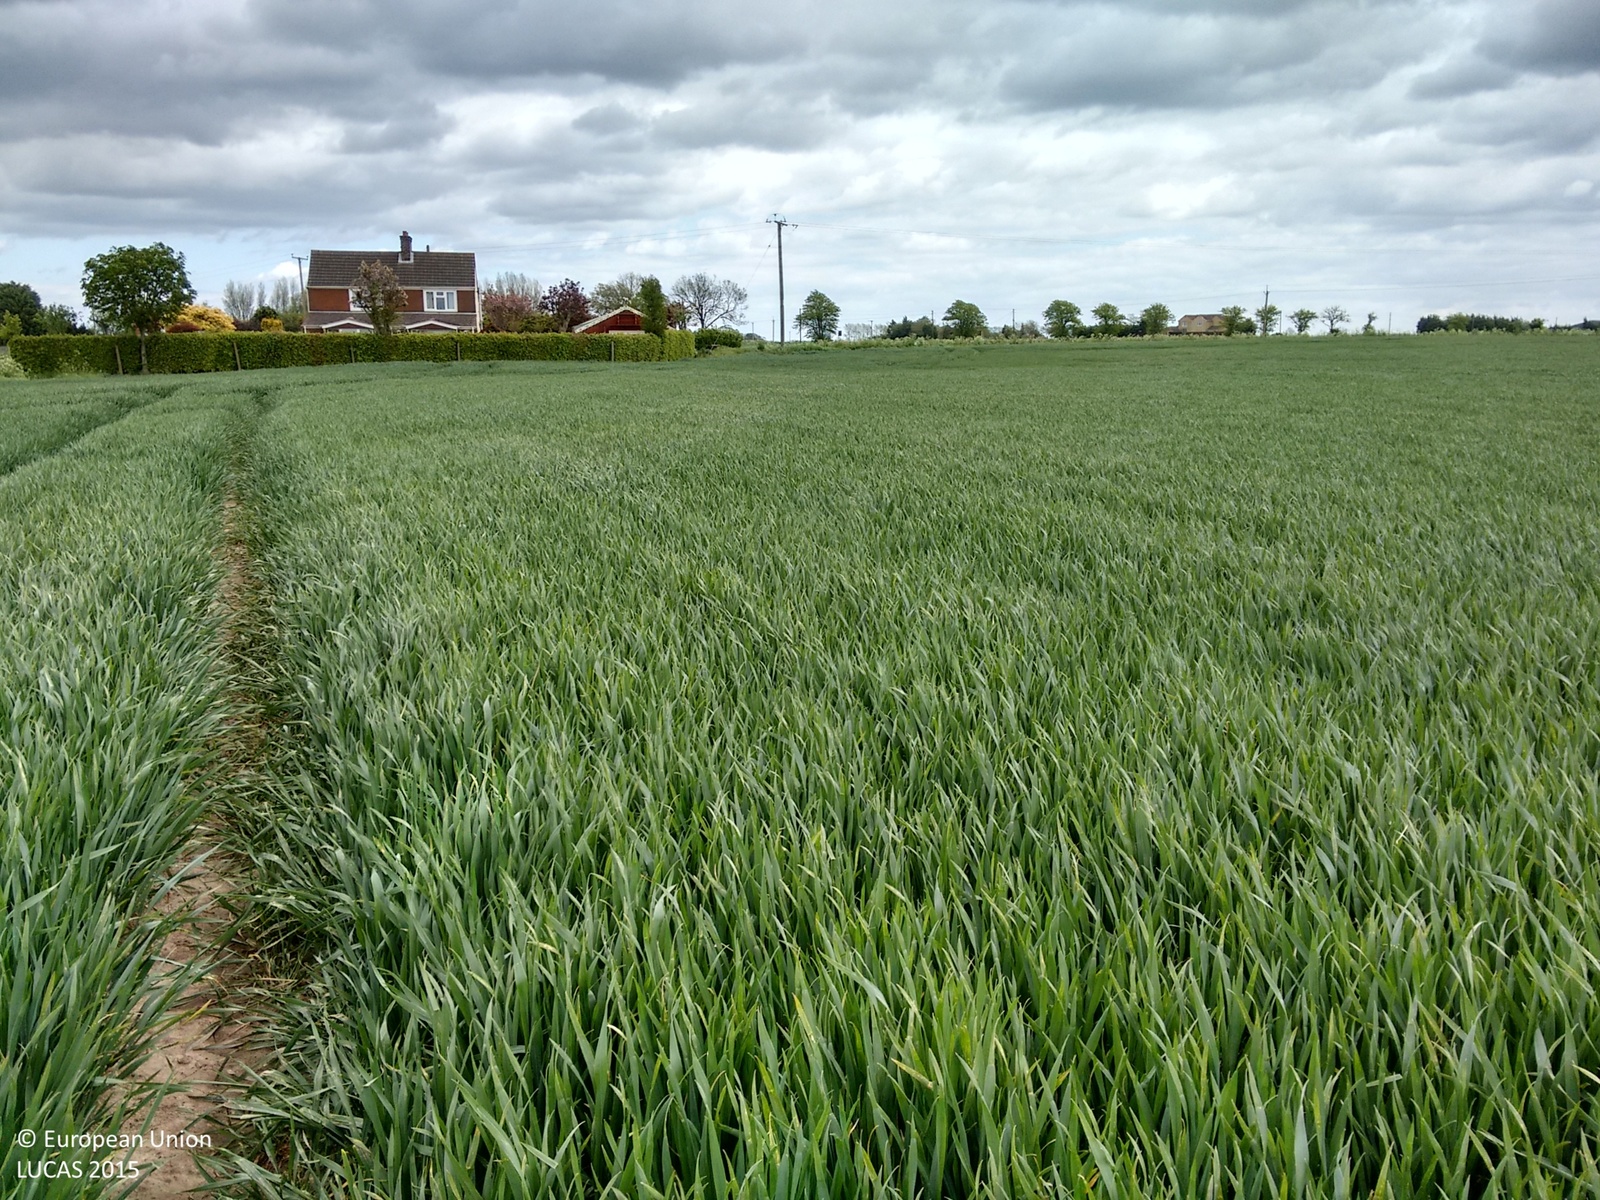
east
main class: Cropland
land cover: Barley
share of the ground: > 75 %
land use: Agriculture (excluding fallow land and kitchen gardens)
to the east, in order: Barley; Grass margins; Electric lines; Grass margins; Ditches and canals; Grass margins; Tracks; Other fresh vegetables; Electric lines; Other fresh vegetables
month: May
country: GB
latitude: 53.0552
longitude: 0.1674
